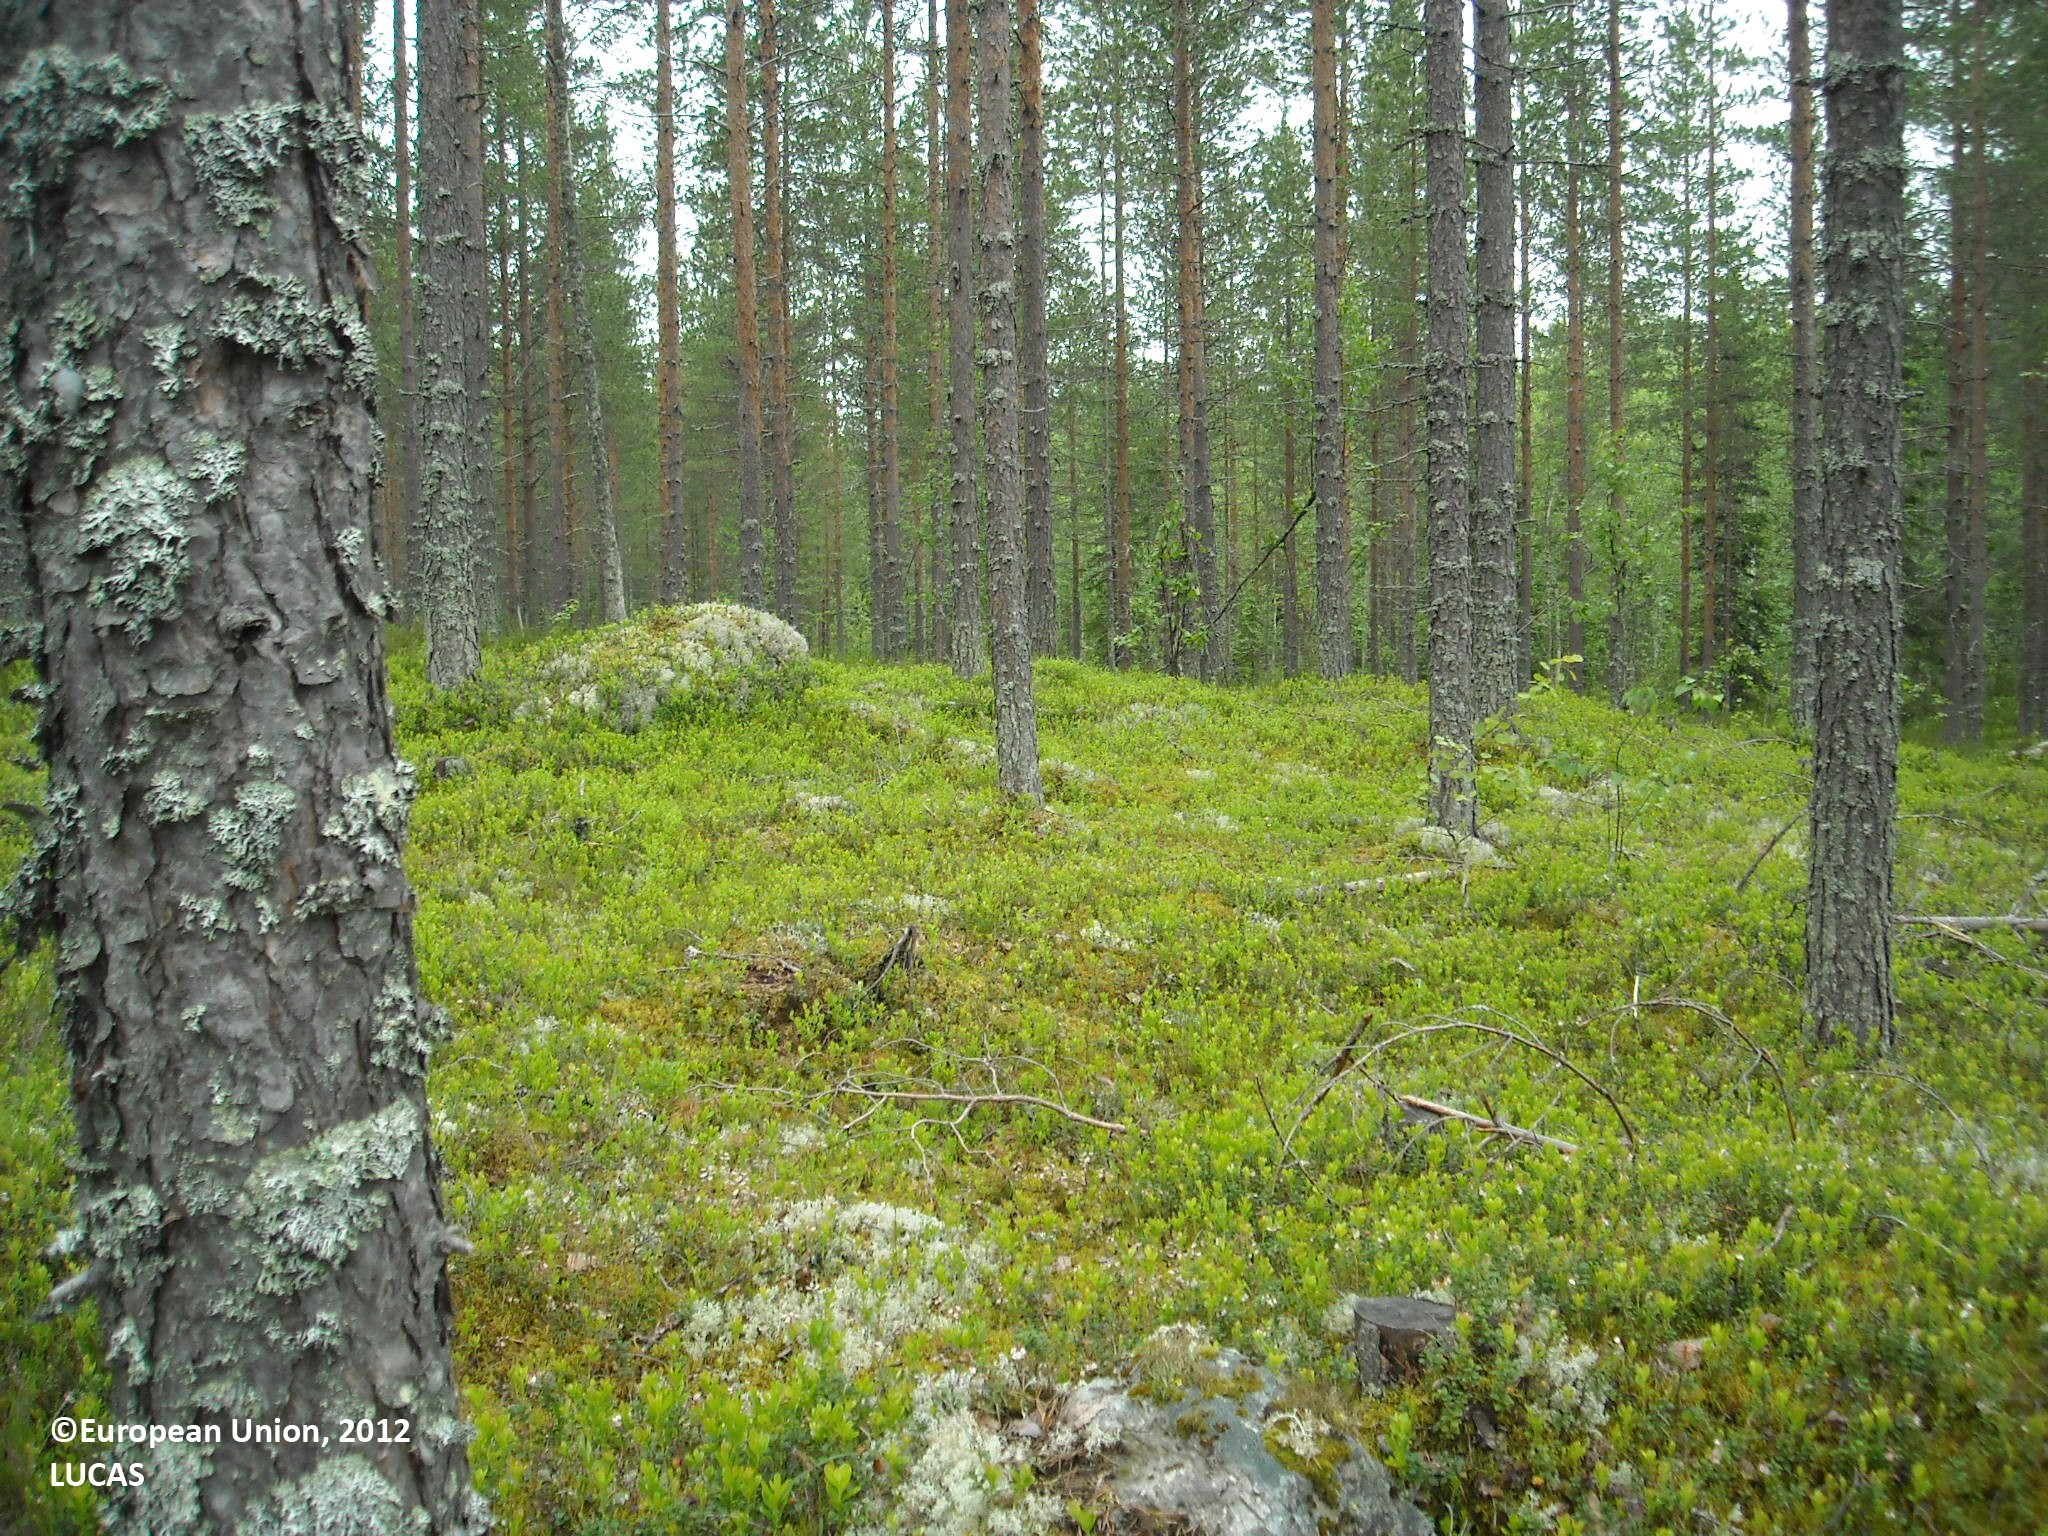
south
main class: Woodland
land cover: Pine dominated coniferous woodland
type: boreal forest
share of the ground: 50 - 75 %
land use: Forestry
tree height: > 5 m
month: June
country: FI
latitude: 64.4952
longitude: 27.3097
